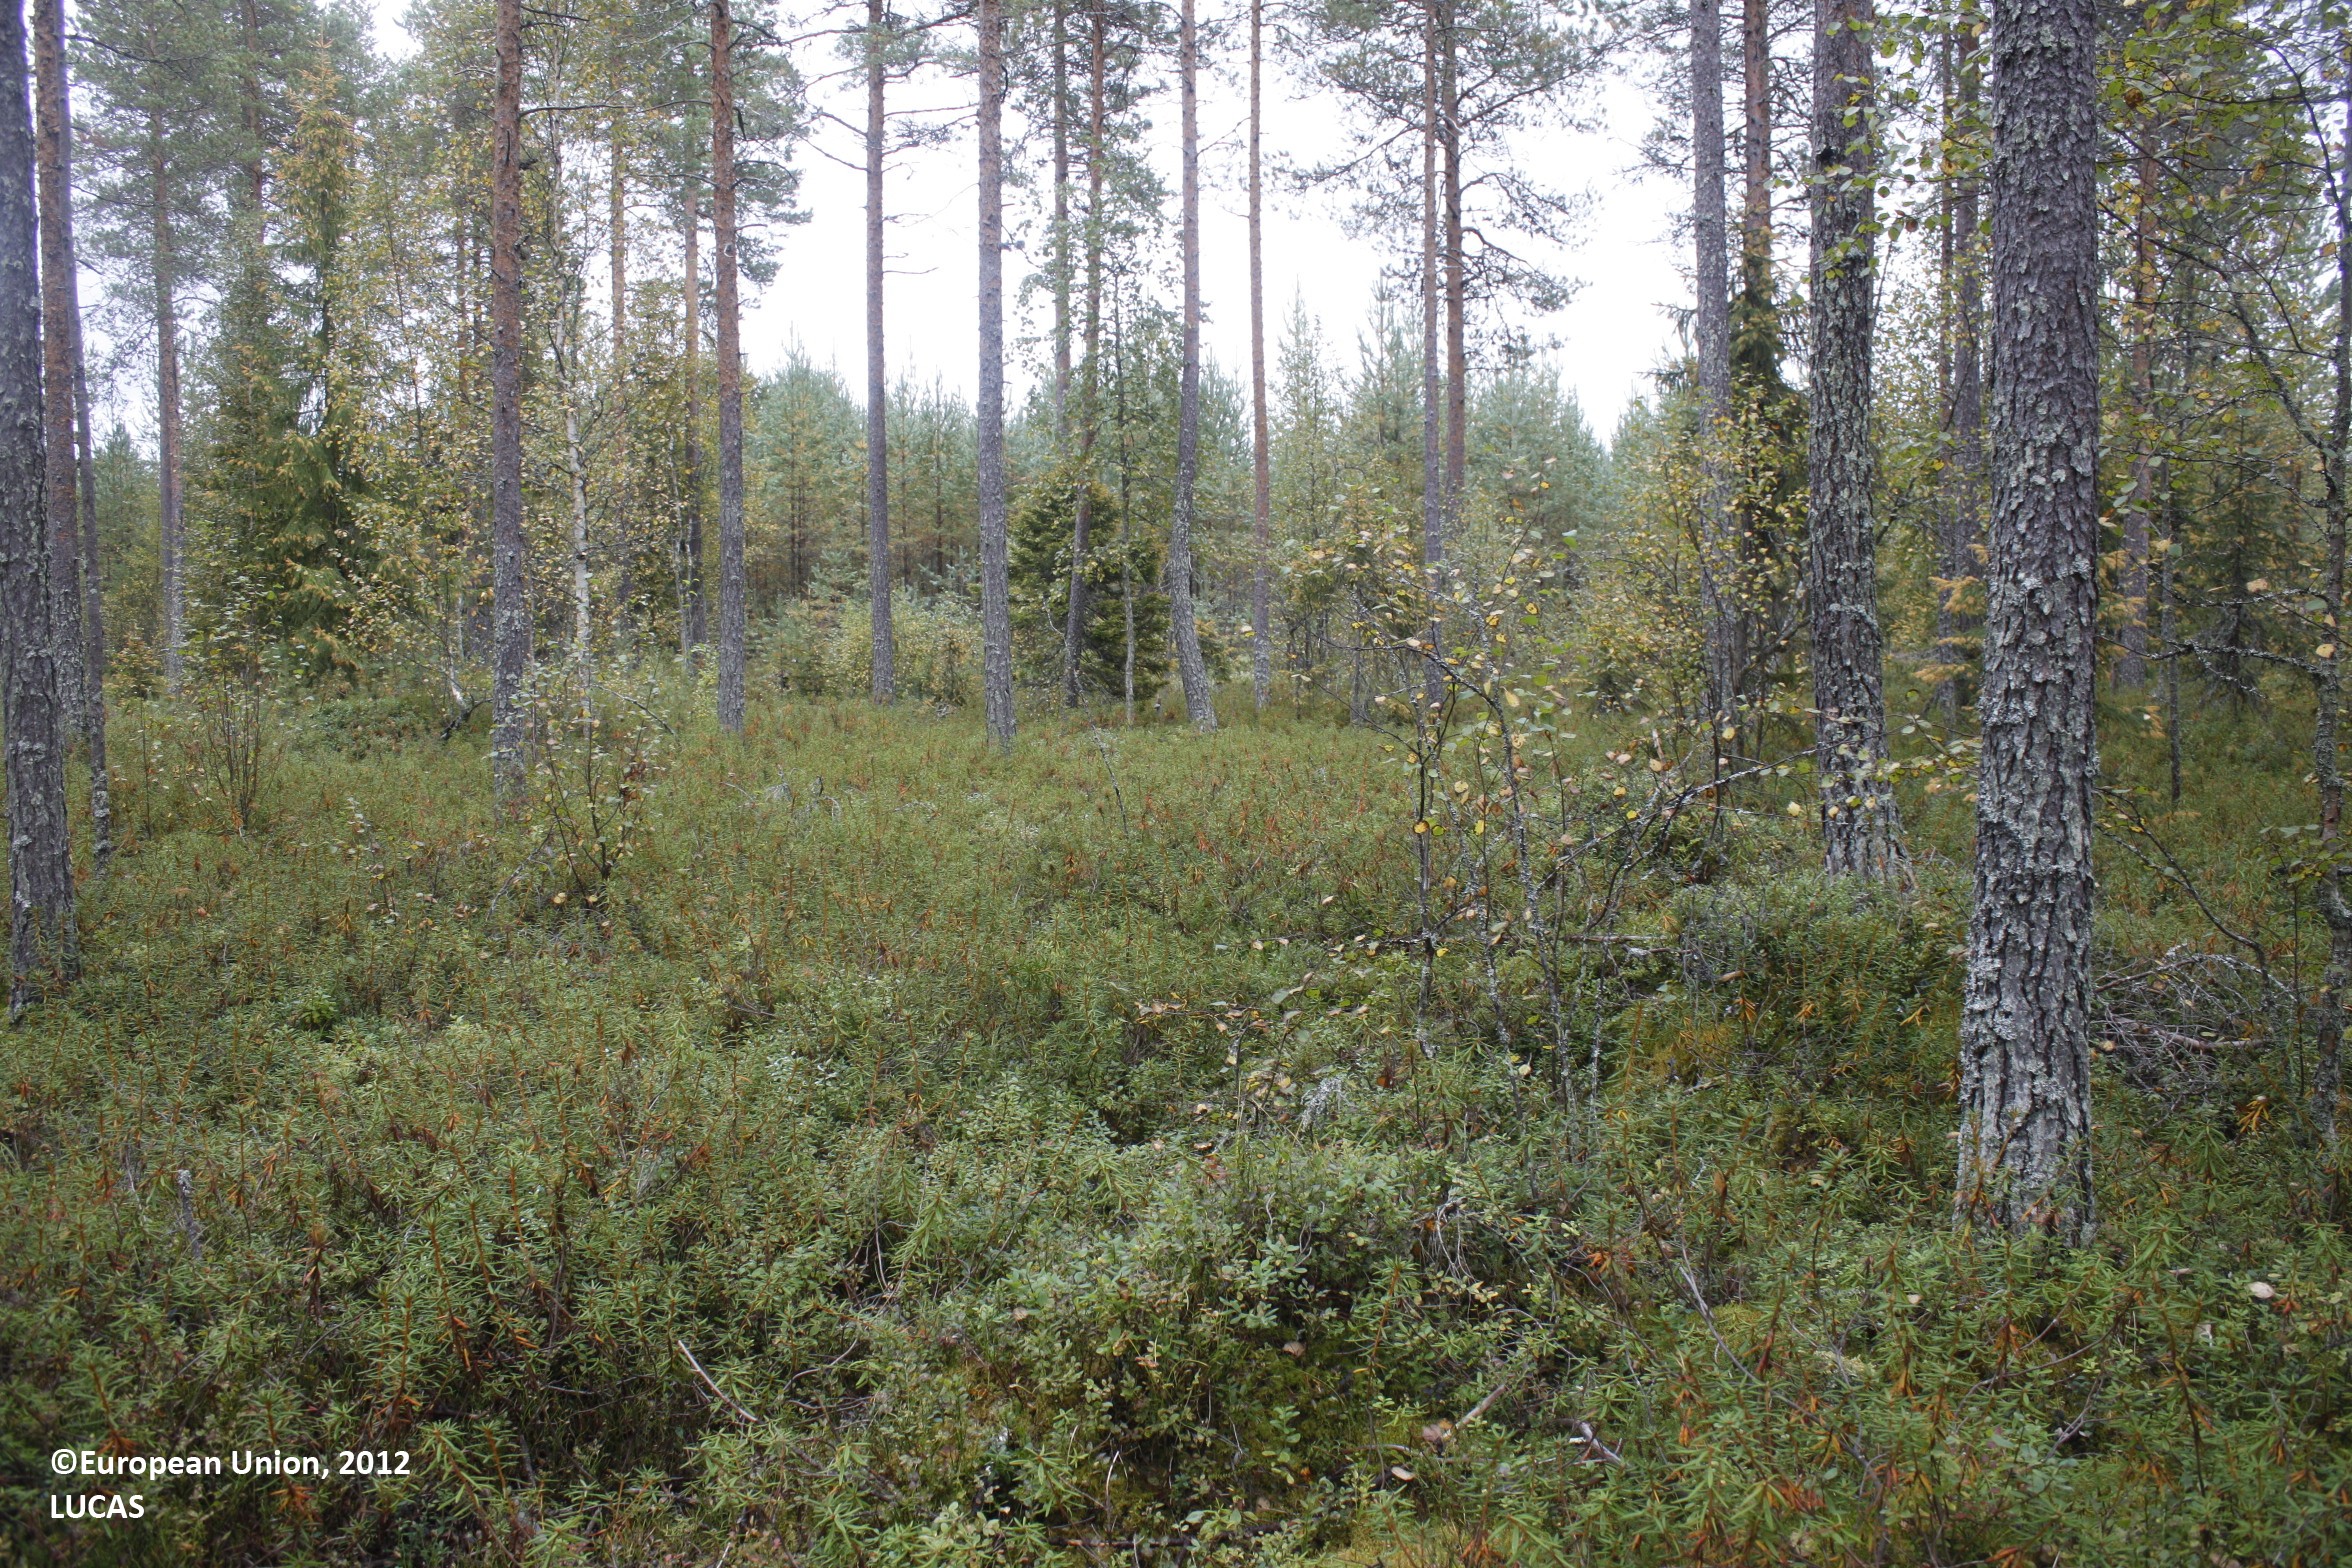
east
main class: Woodland
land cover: Pine dominated mixed woodland
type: boreal forest
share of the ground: 25 - 50 %
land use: Forestry
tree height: > 5 m
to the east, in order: Pine dominated mixed woodland; Ditches and canals; Pine dominated mixed woodland; Ditches and canals; Pine dominated mixed woodland; Tracks; Spruce dominated mixed woodland; Pine dominated mixed woodland; Ditches and canals; Pine dominated mixed woodland; Inland running water; Pine dominated mixed woodland
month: September
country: FI
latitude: 65.1269
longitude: 26.7984
